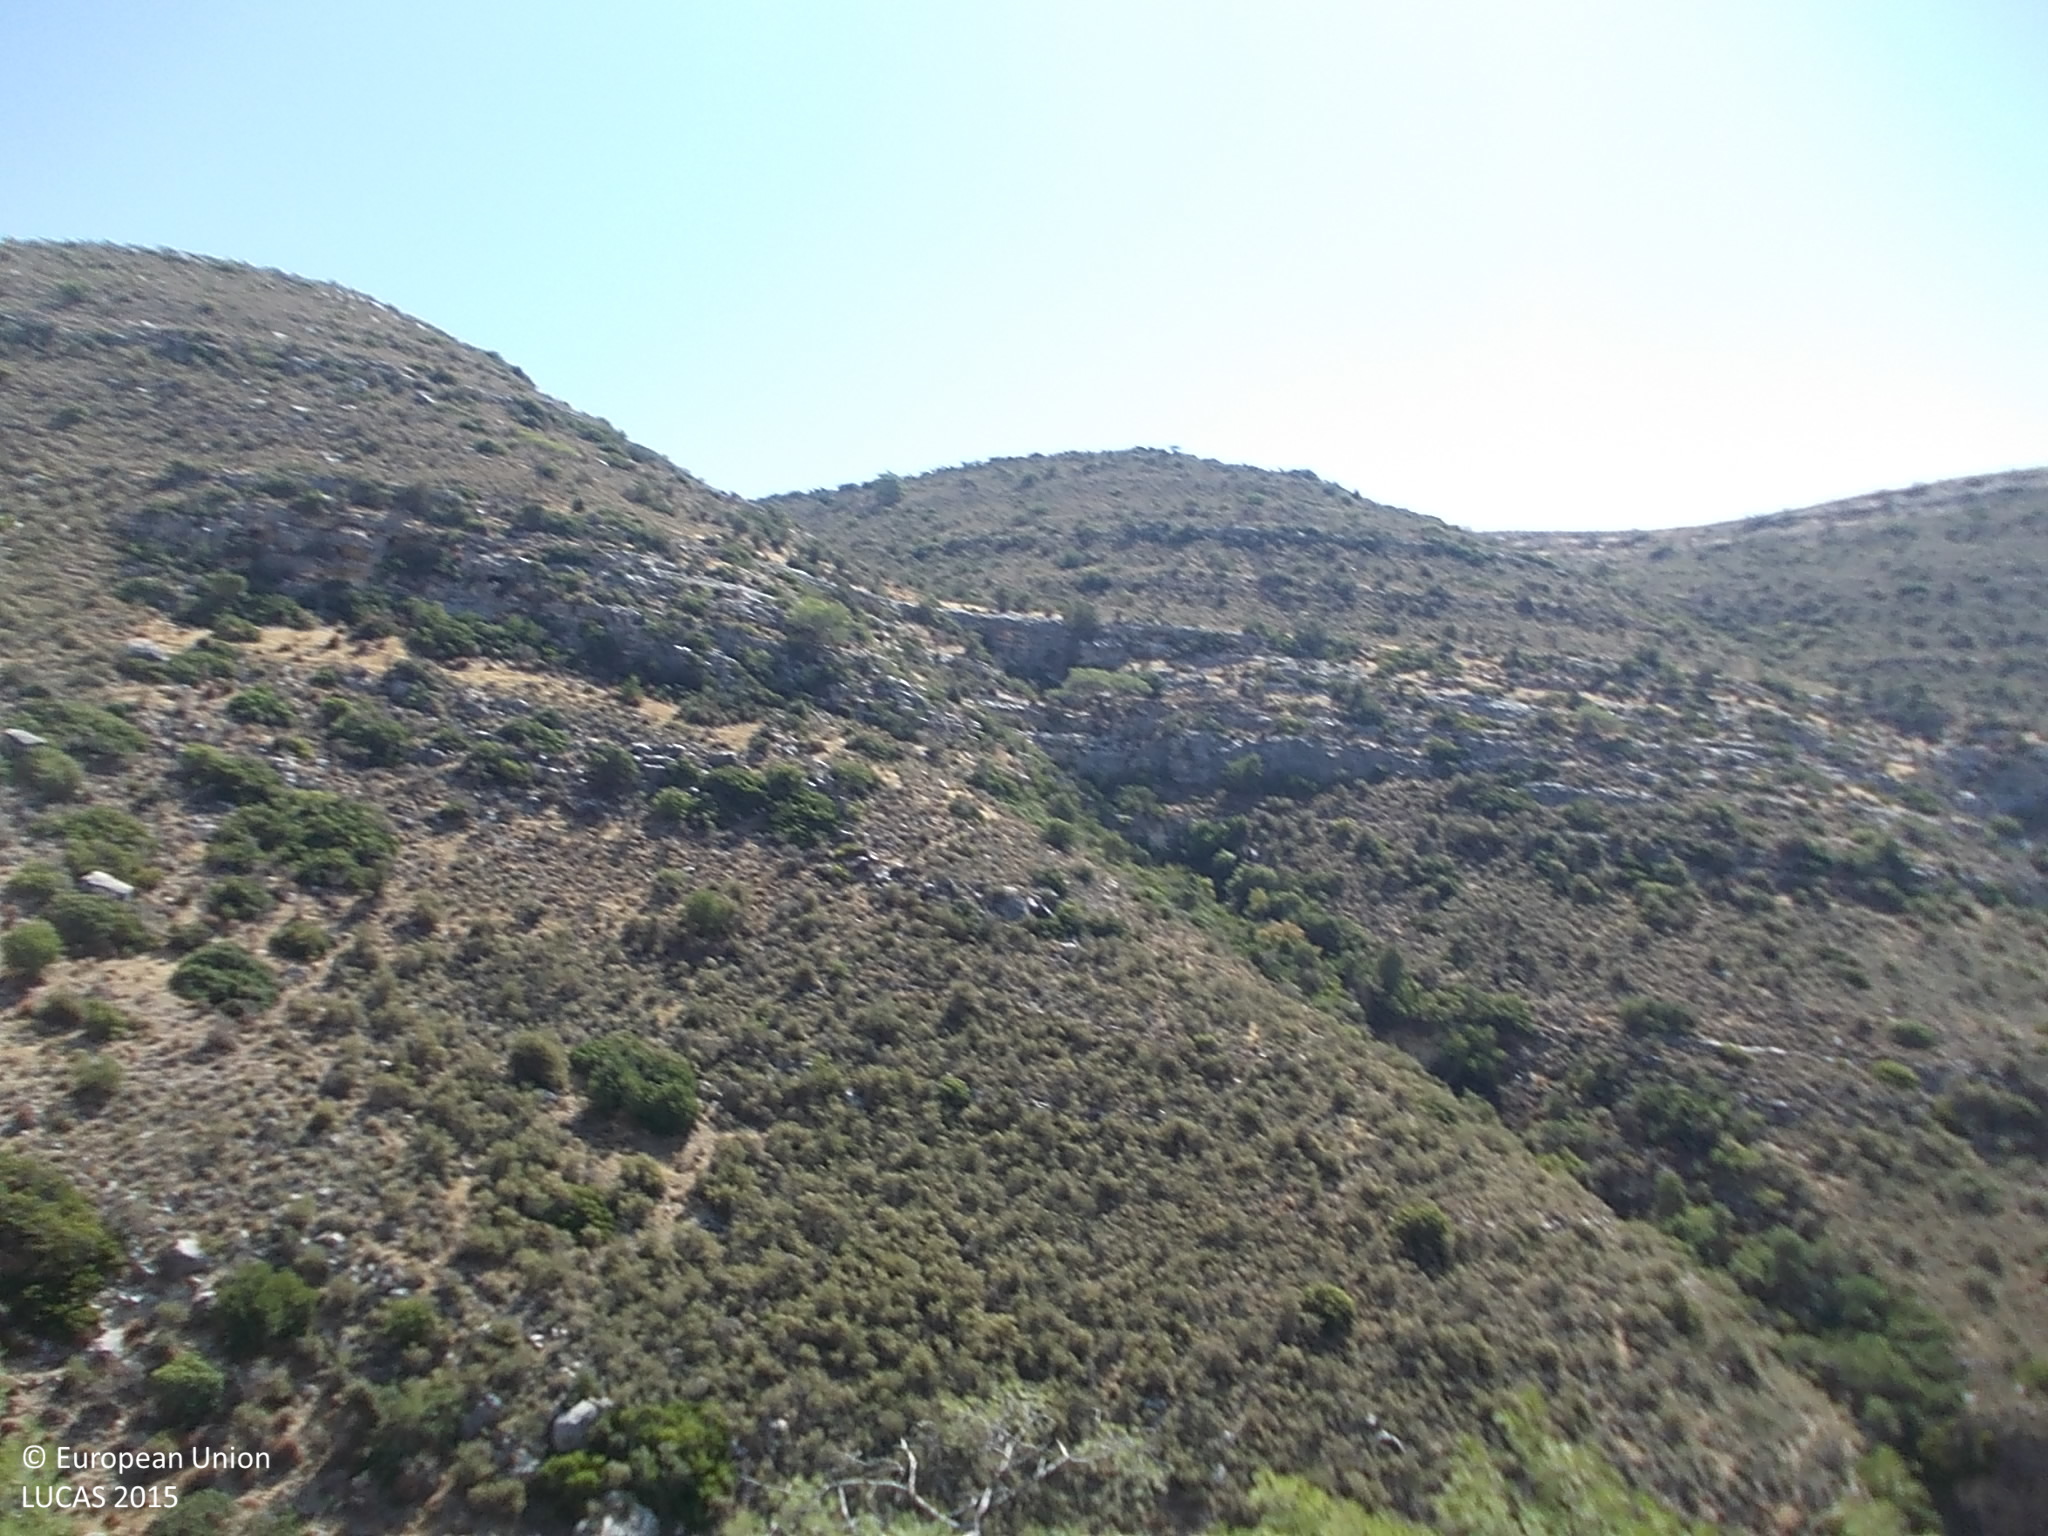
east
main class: Shrubland
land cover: Shrubland without tree cover
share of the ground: 50 - 75 %
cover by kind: shrubs 60 %, unconsolidated bare surface 20 %, herbaceous plants 10 %, consolidated bare surface 10 %
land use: Semi-natural and natural areas not in use
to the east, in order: Shrubland without tree cover; Broadleaved woodland; Inland fresh running water; Broadleaved woodland; Shrubland without tree cover
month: September
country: CY
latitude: 34.7331
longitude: 32.7972
